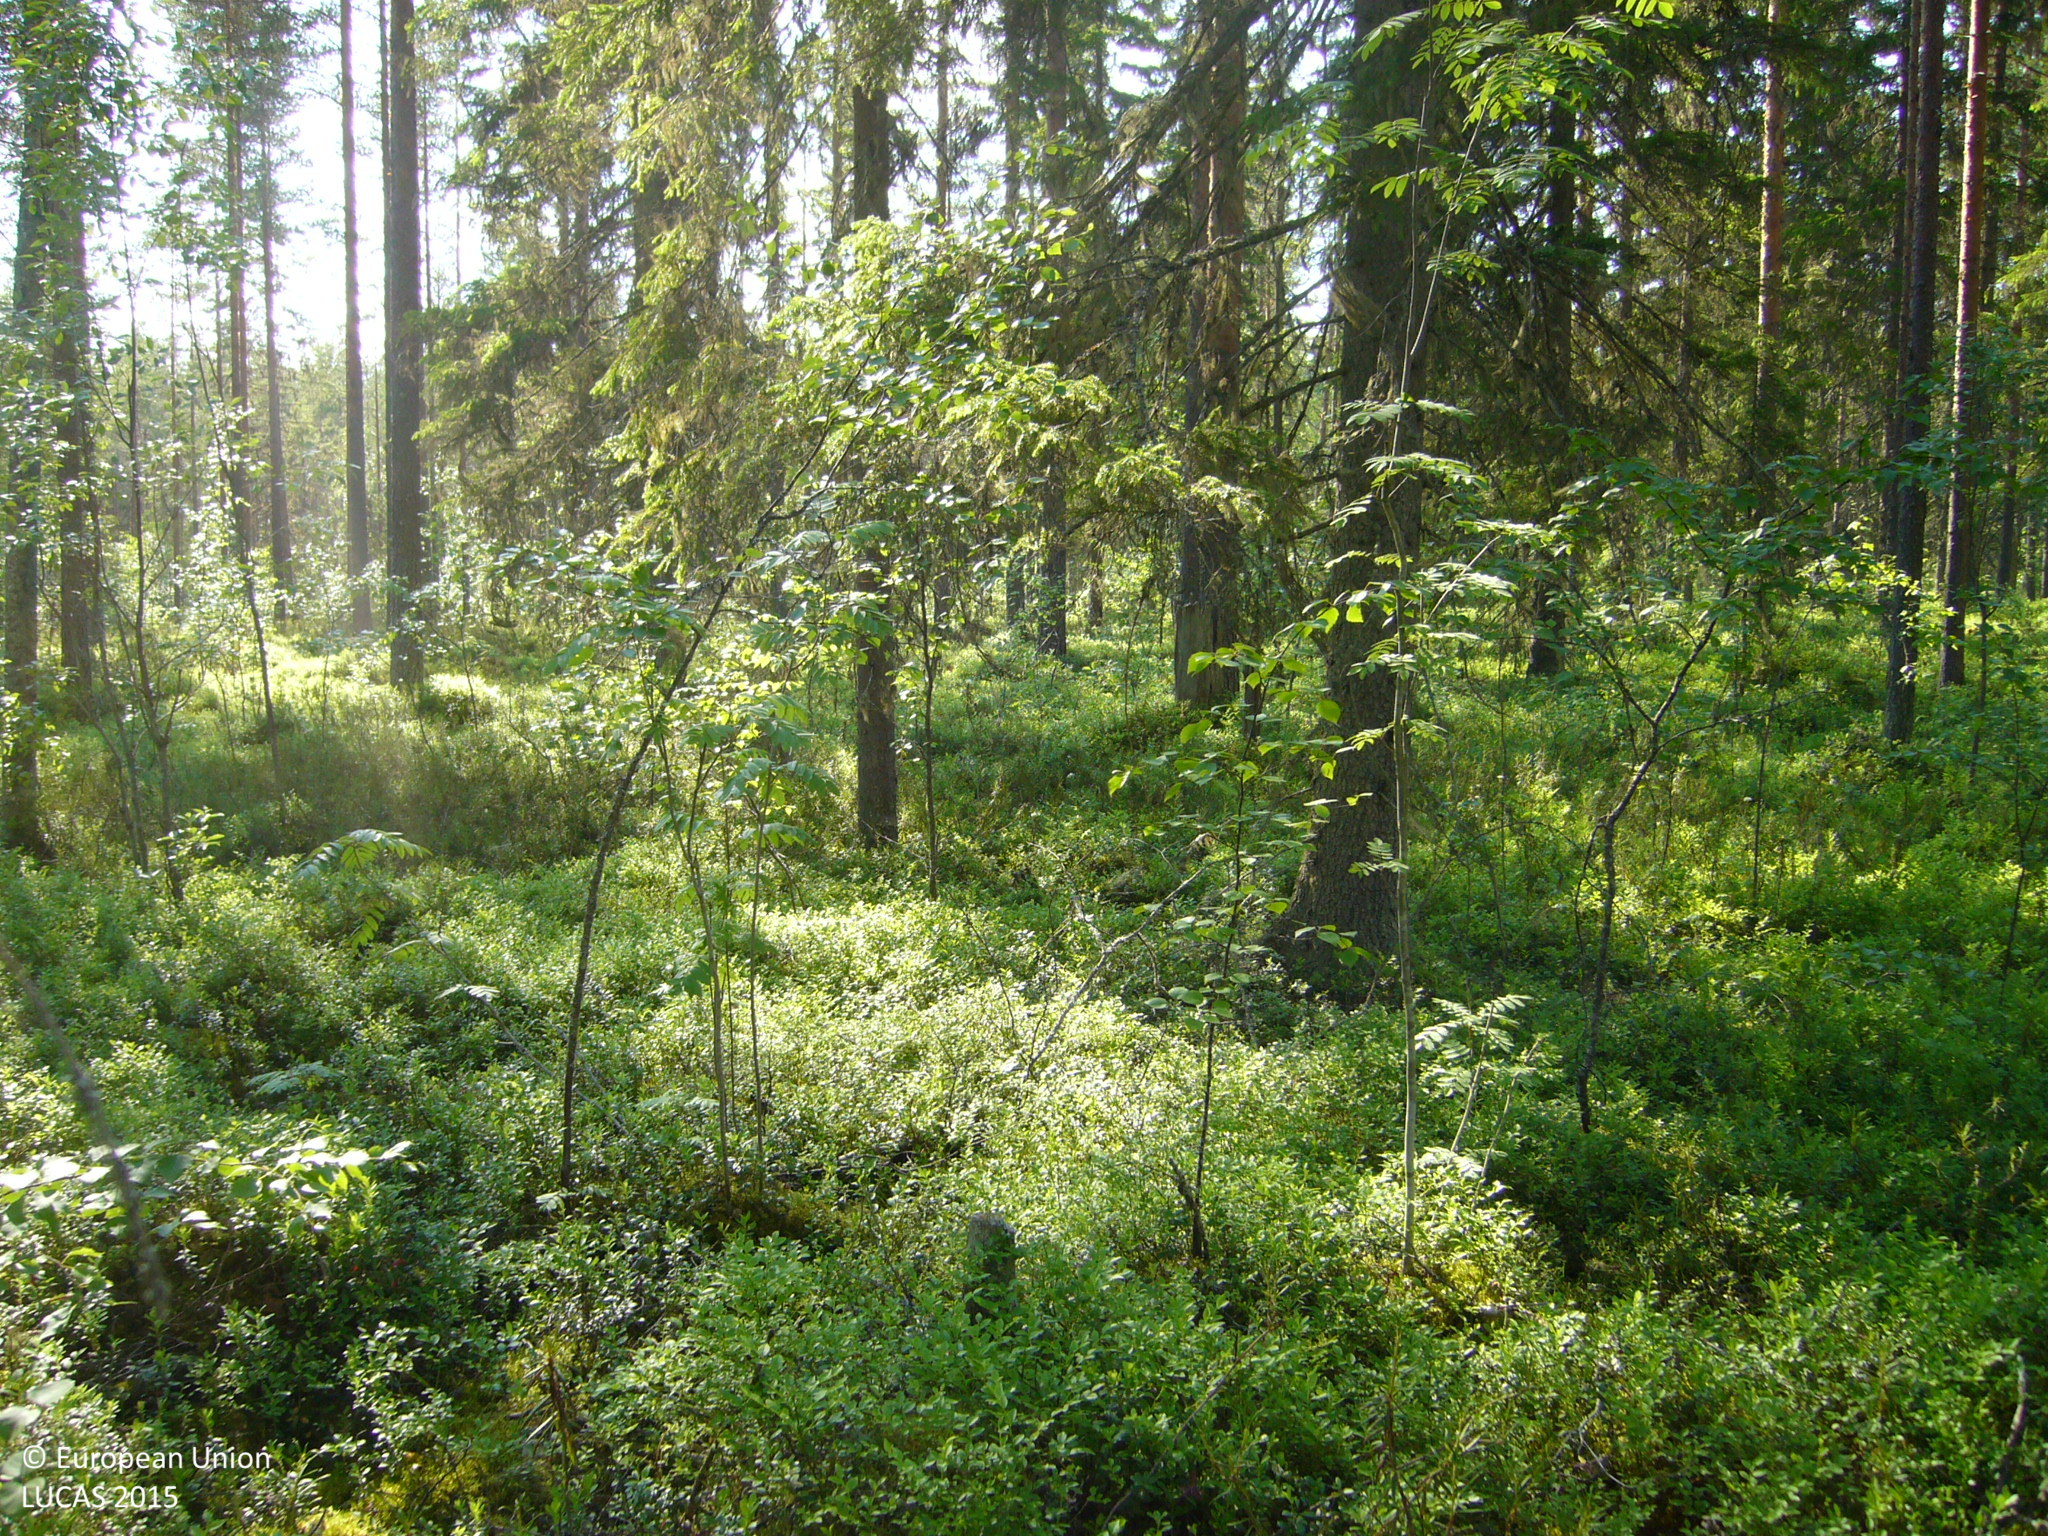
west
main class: Woodland
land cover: Pine dominated coniferous woodland
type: boreal forest
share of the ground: 50 - 75 %
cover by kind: coniferous forest trees 60 %, shrubs 40 %
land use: Forestry
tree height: > 5 m
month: July
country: FI
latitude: 63.5065
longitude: 25.8007
